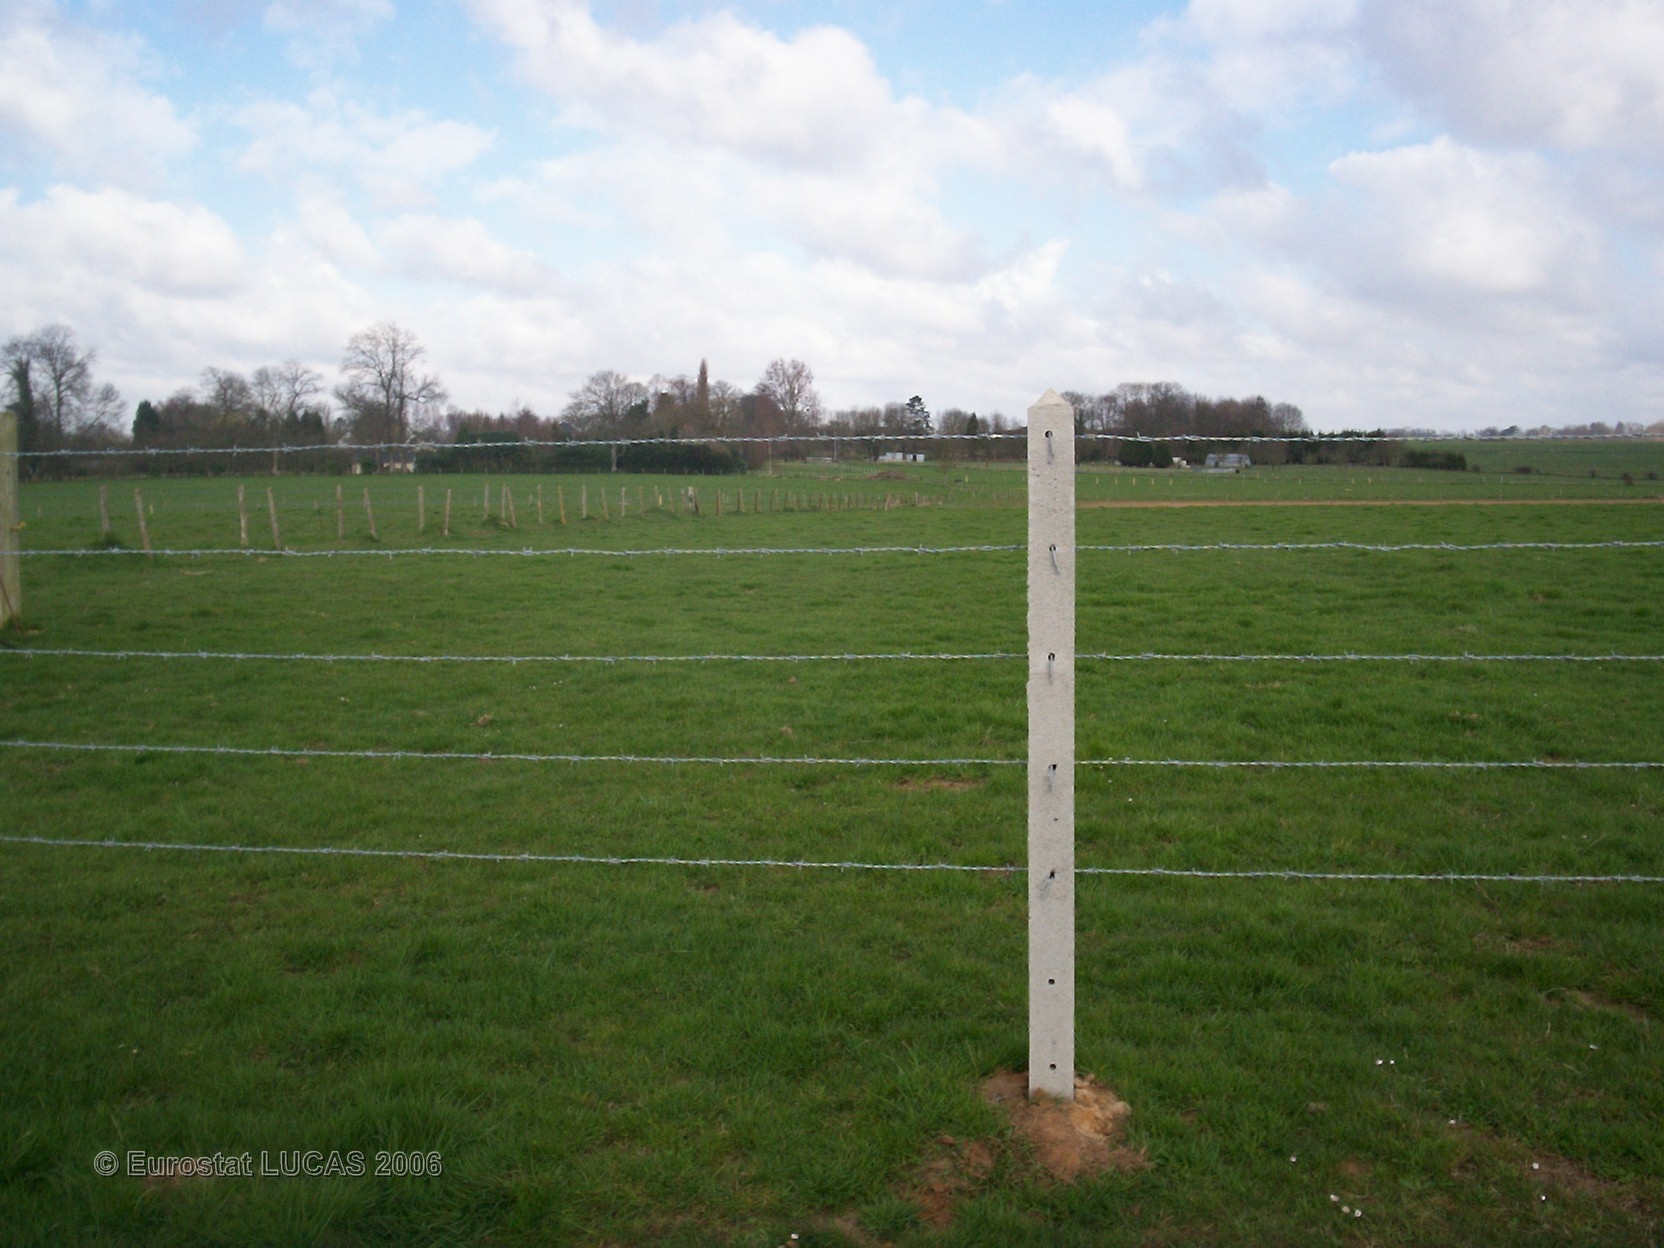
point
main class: Grassland
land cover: Grassland without tree/shrub cover
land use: Agriculture (excluding fallow land and kitchen gardens)
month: April
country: FR
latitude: 49.5679
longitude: 0.9201
